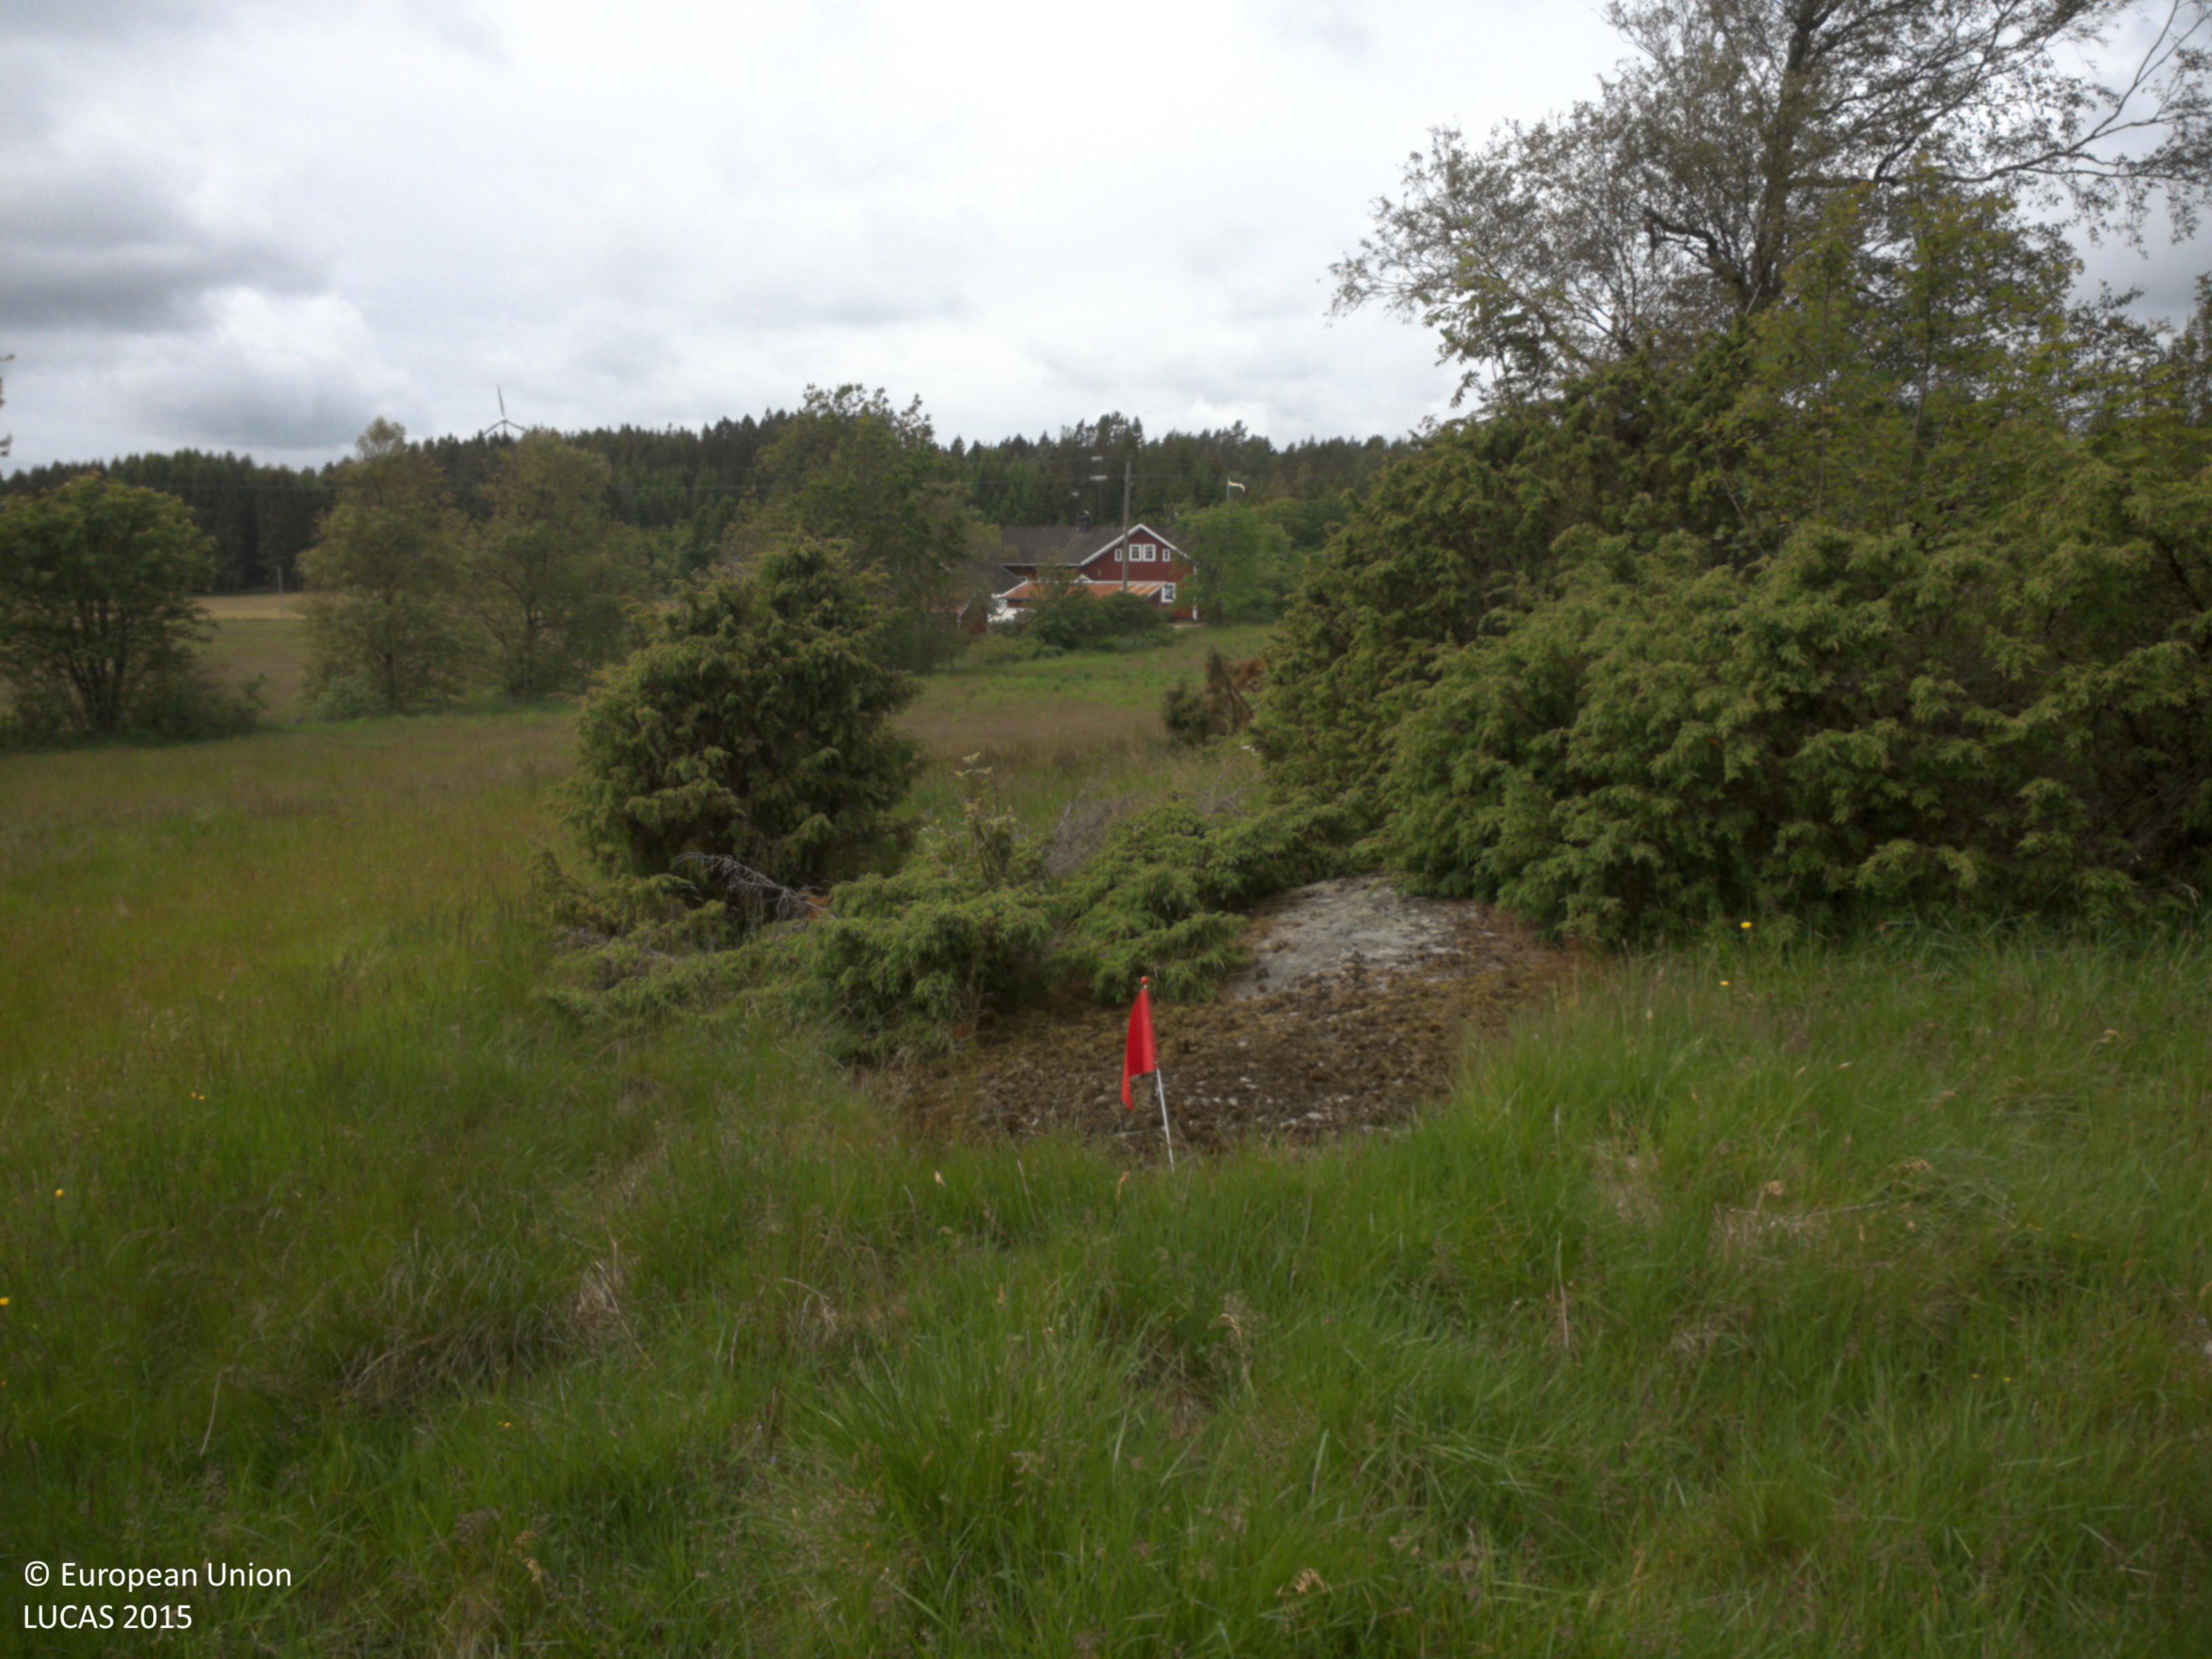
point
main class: Grassland
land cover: Grassland with sparse tree/shrub cover
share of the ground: > 75 %
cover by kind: herbaceous plants 95 %, coniferous forest trees 5 %
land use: Agriculture (excluding fallow land and kitchen gardens)
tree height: < 5 m
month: June
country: SE
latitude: 58.3728
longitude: 11.5185
